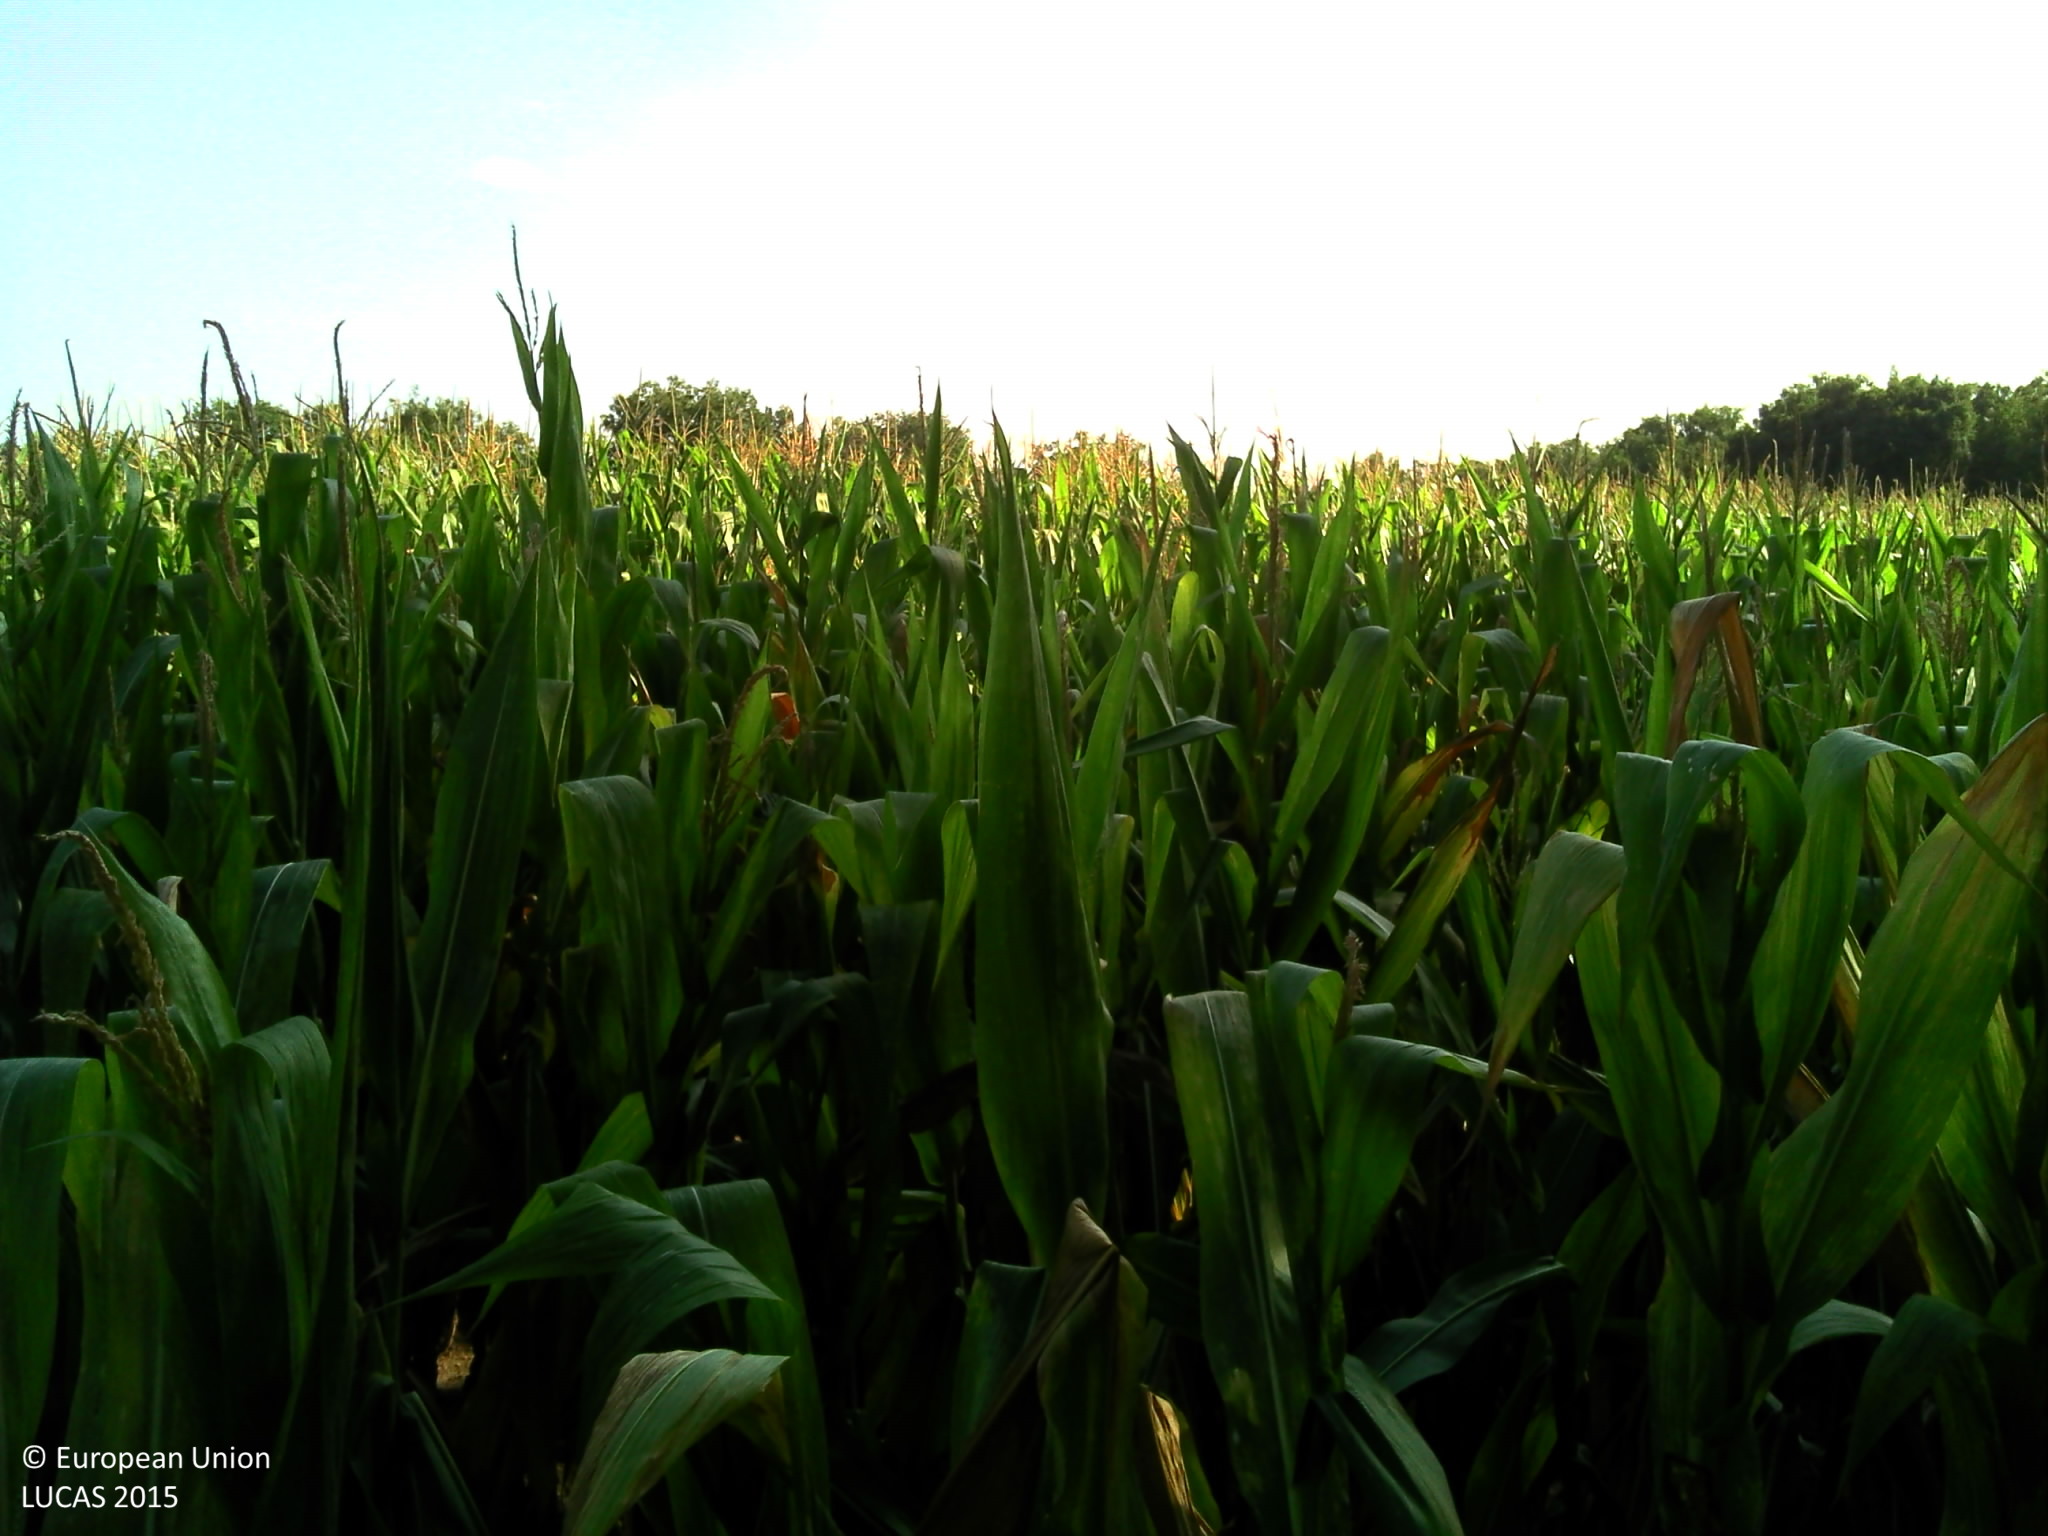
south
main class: Cropland
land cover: Maize
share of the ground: > 75 %
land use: Agriculture (excluding fallow land and kitchen gardens)
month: August
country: FR
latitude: 45.6666
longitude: 4.1369
